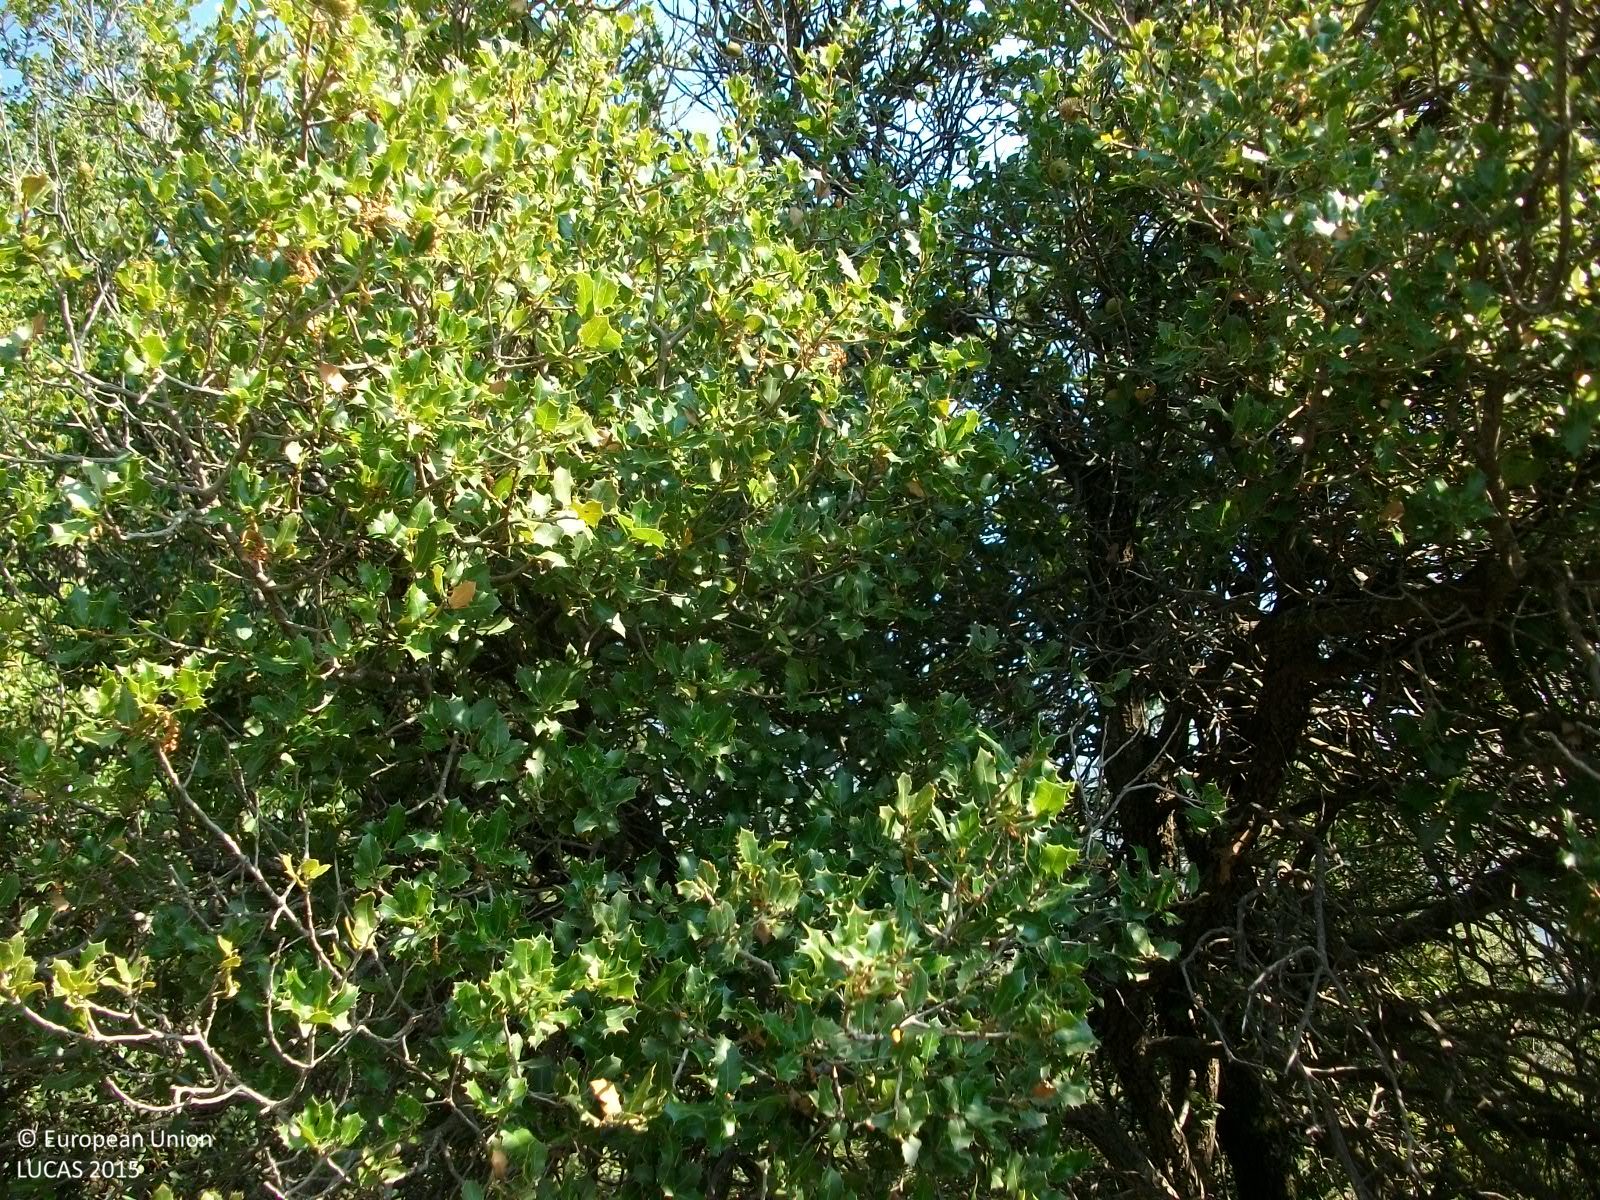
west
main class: Shrubland
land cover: Shrubland with sparse tree cover
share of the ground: > 75 %
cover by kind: shrubs 75 %, unconsolidated bare surface 15 %, broadleaved forest trees 5 %, herbaceous plants 5 %
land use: Agriculture (excluding fallow land and kitchen gardens)
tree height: < 5 m
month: July
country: GR
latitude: 36.9320
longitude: 22.4045
